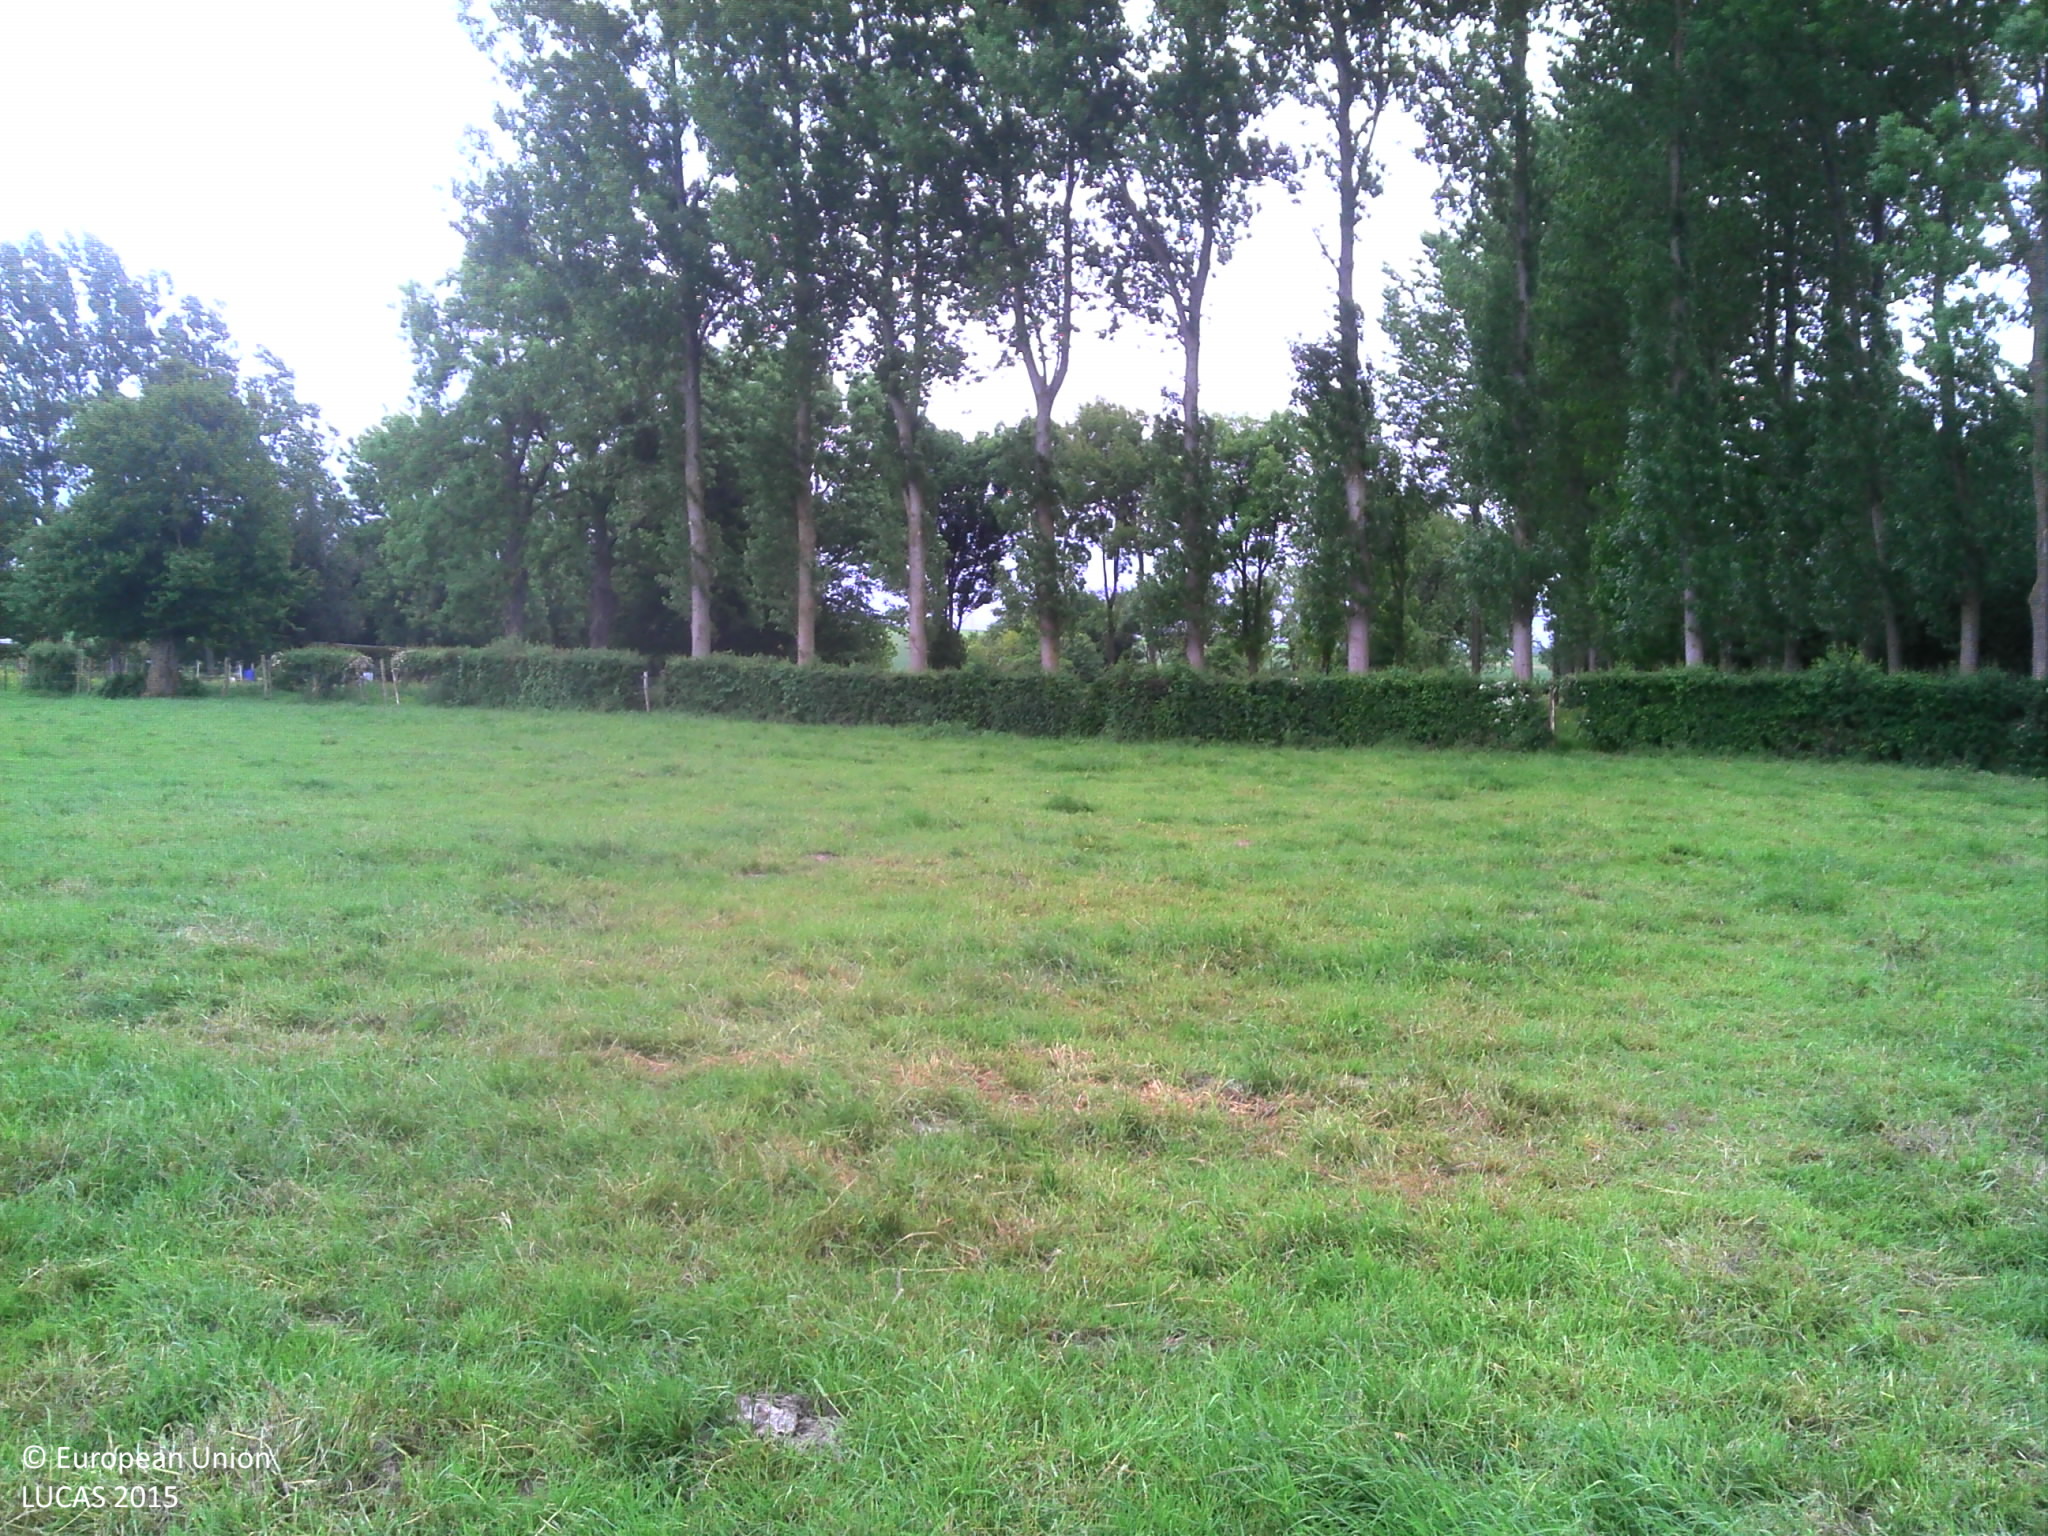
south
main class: Grassland
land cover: Grassland without tree/shrub cover
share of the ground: > 75 %
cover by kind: herbaceous plants 100 %
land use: Agriculture (excluding fallow land and kitchen gardens)
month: May
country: FR
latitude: 50.0599
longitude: 1.6710
